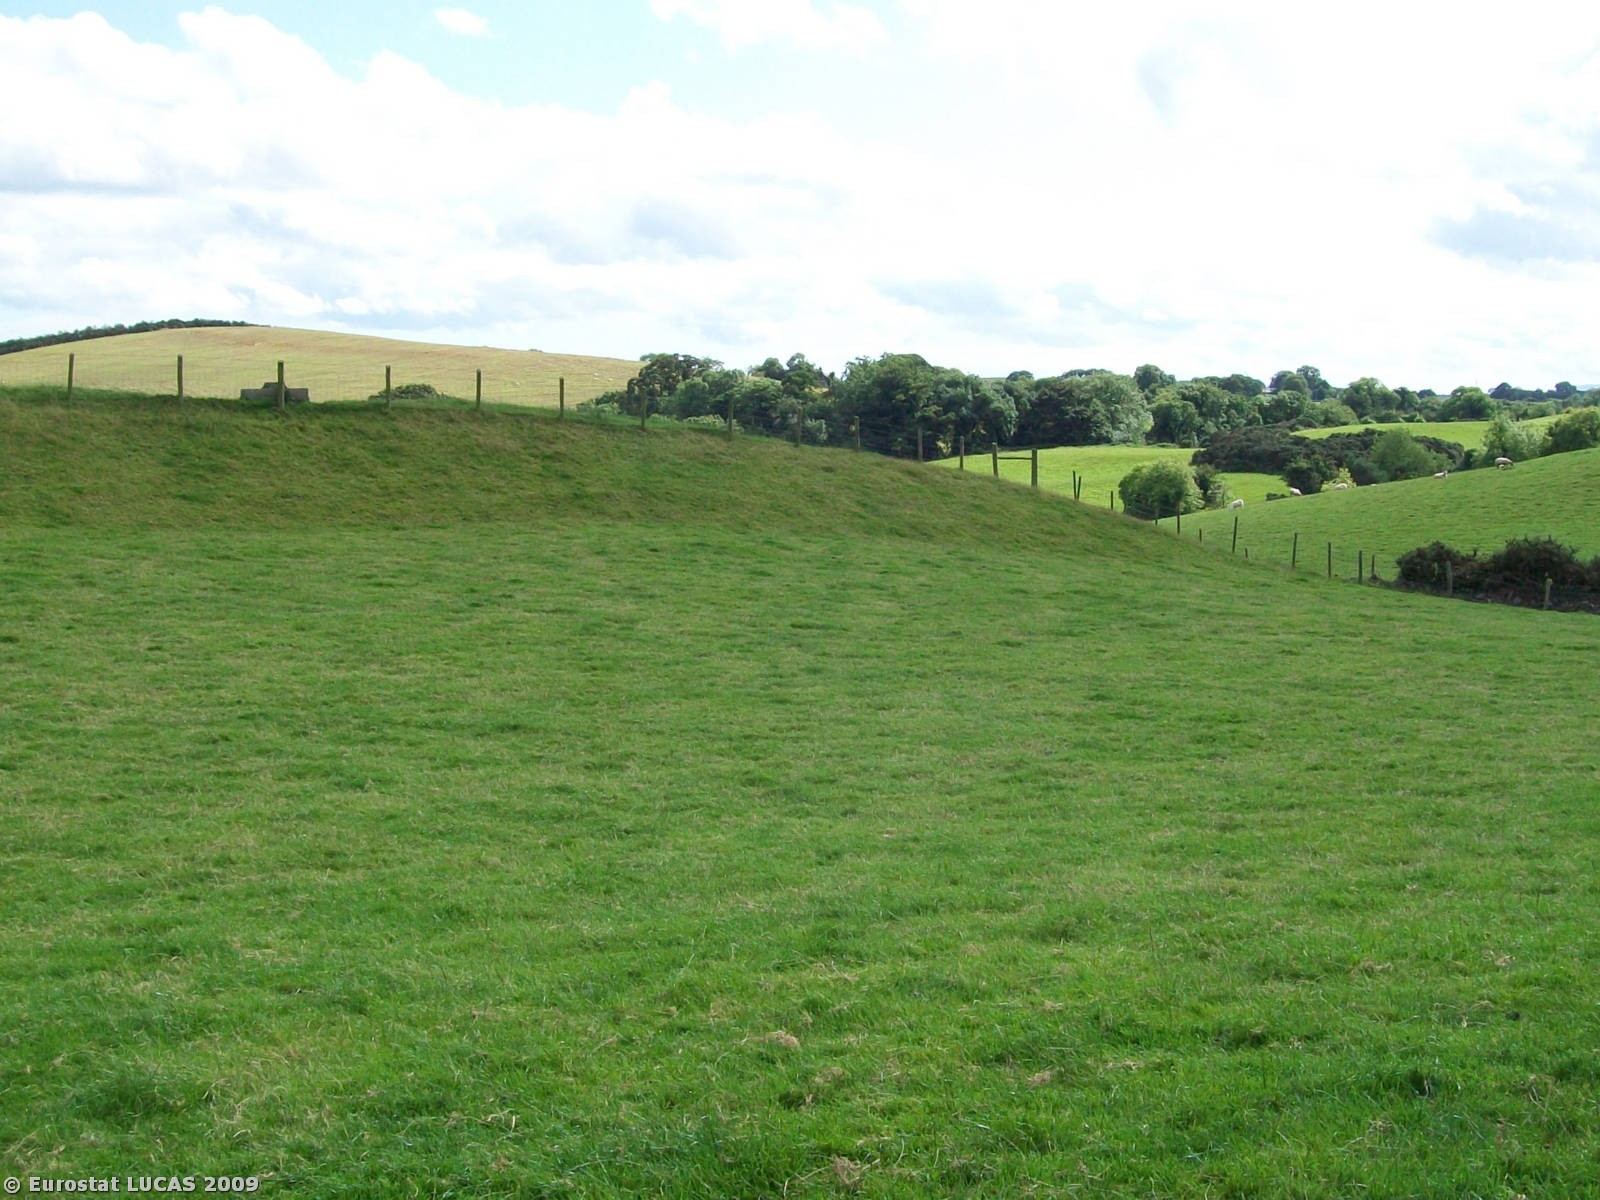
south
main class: Grassland
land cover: Grassland without tree/shrub cover
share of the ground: > 75 %
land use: Agriculture (excluding fallow land and kitchen gardens)
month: August
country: GB
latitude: 54.4639
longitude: -5.6677
